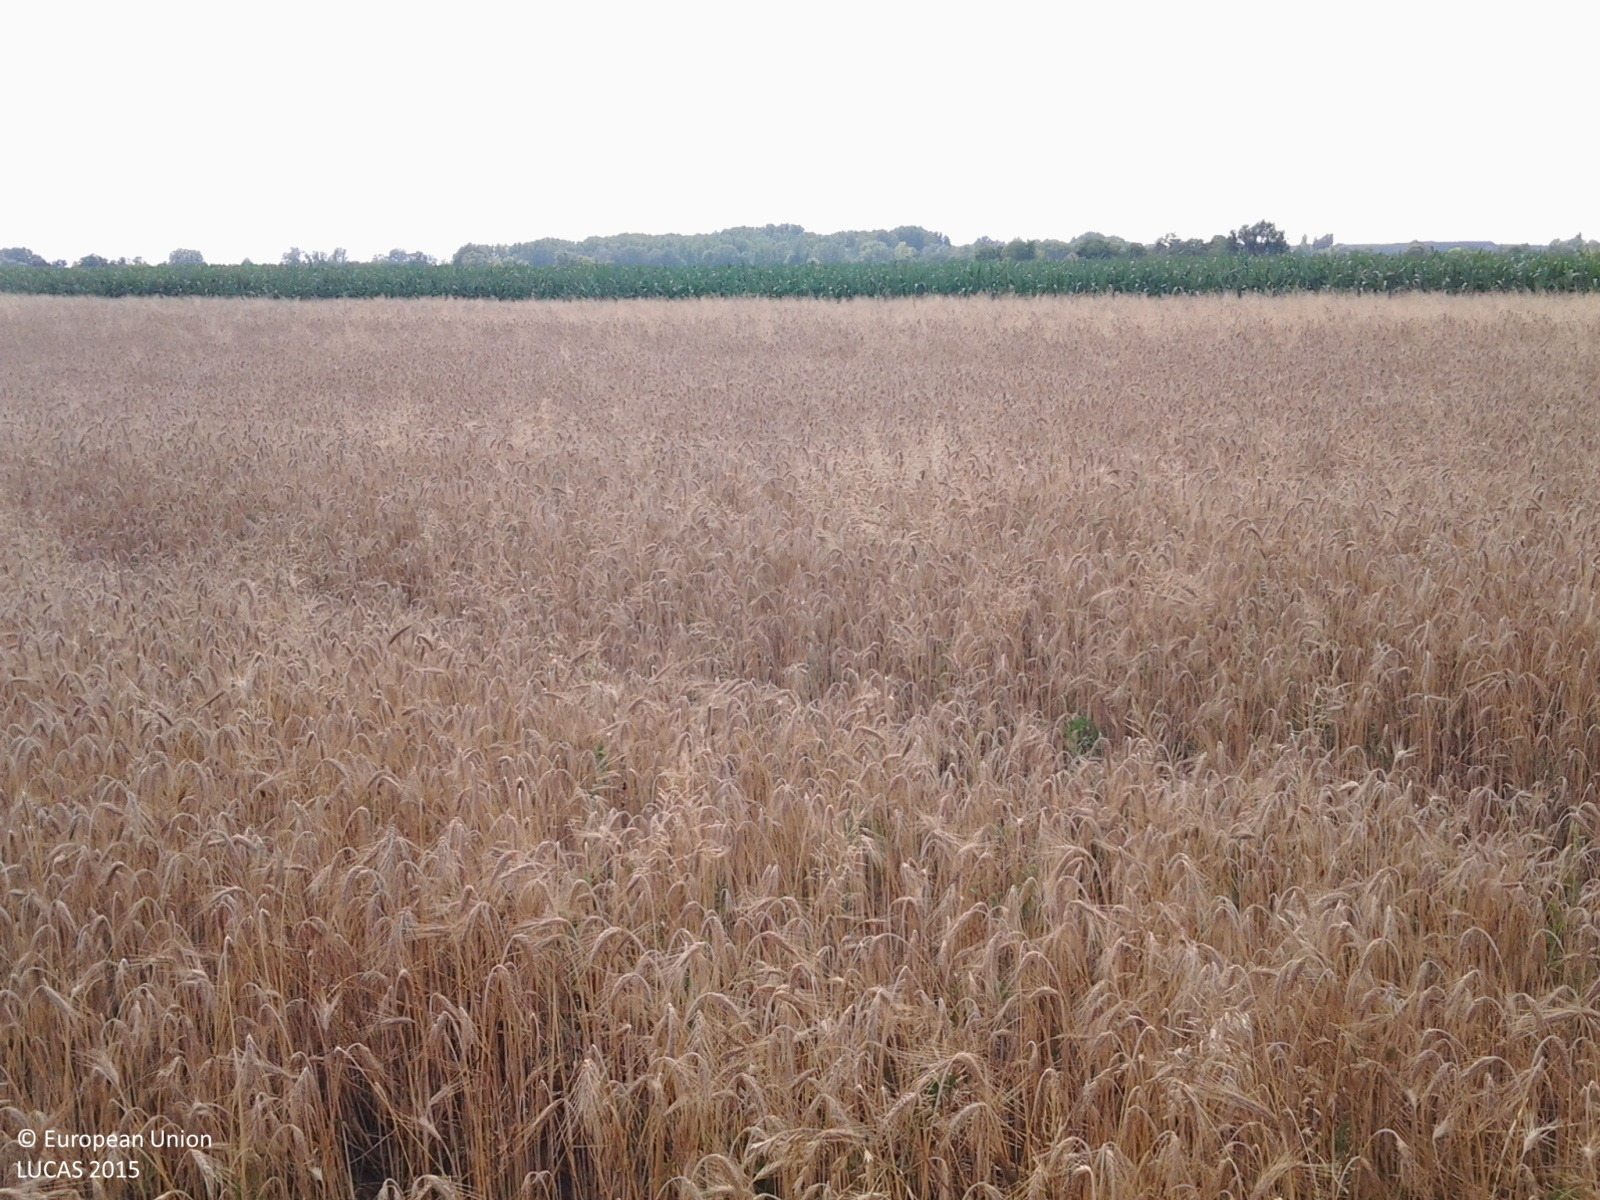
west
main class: Cropland
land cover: Triticale
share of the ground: > 75 %
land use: Agriculture (excluding fallow land and kitchen gardens)
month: July
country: HU
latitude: 47.4572
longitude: 19.8266
